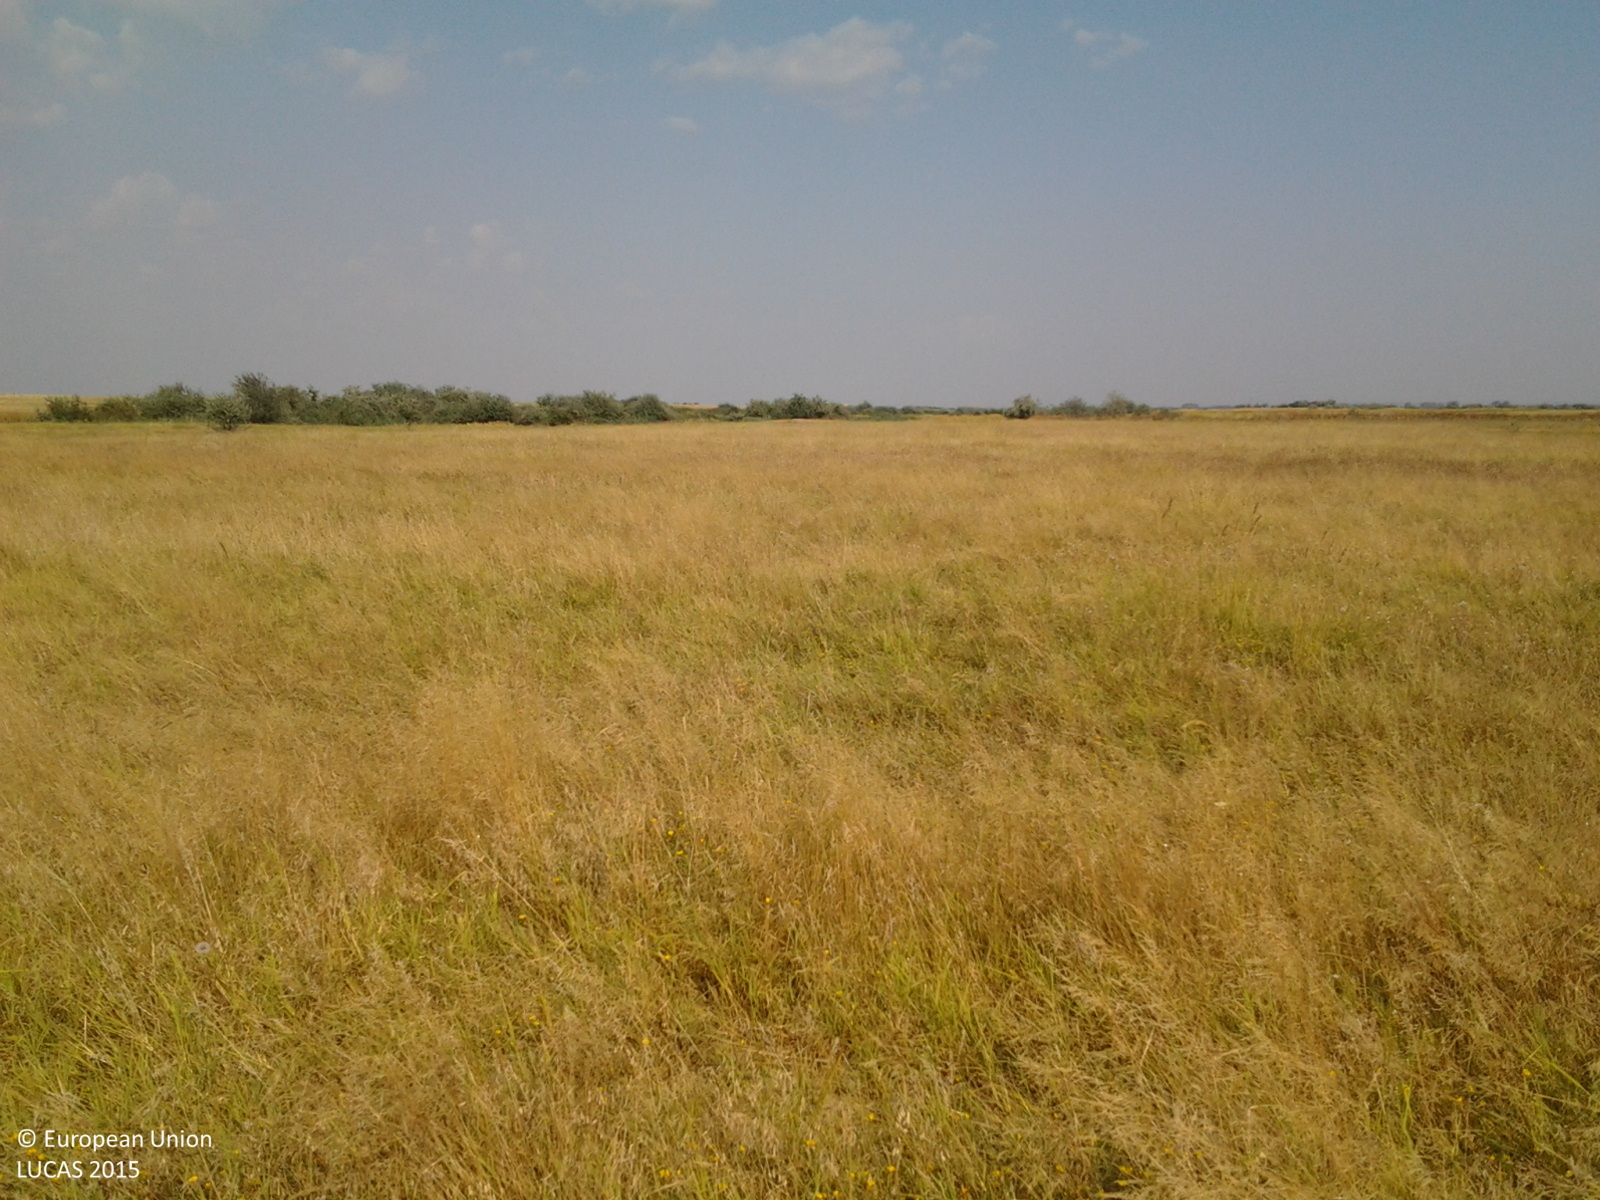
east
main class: Grassland
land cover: Spontaneously vegetated surfaces
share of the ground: > 75 %
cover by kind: herbaceous plants 100 %
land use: Fallow land
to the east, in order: Spontaneously vegetated surfaces; Ditches and canals; Abandoned hedges; Common wheat
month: August
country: RO
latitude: 43.9117
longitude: 23.0037
